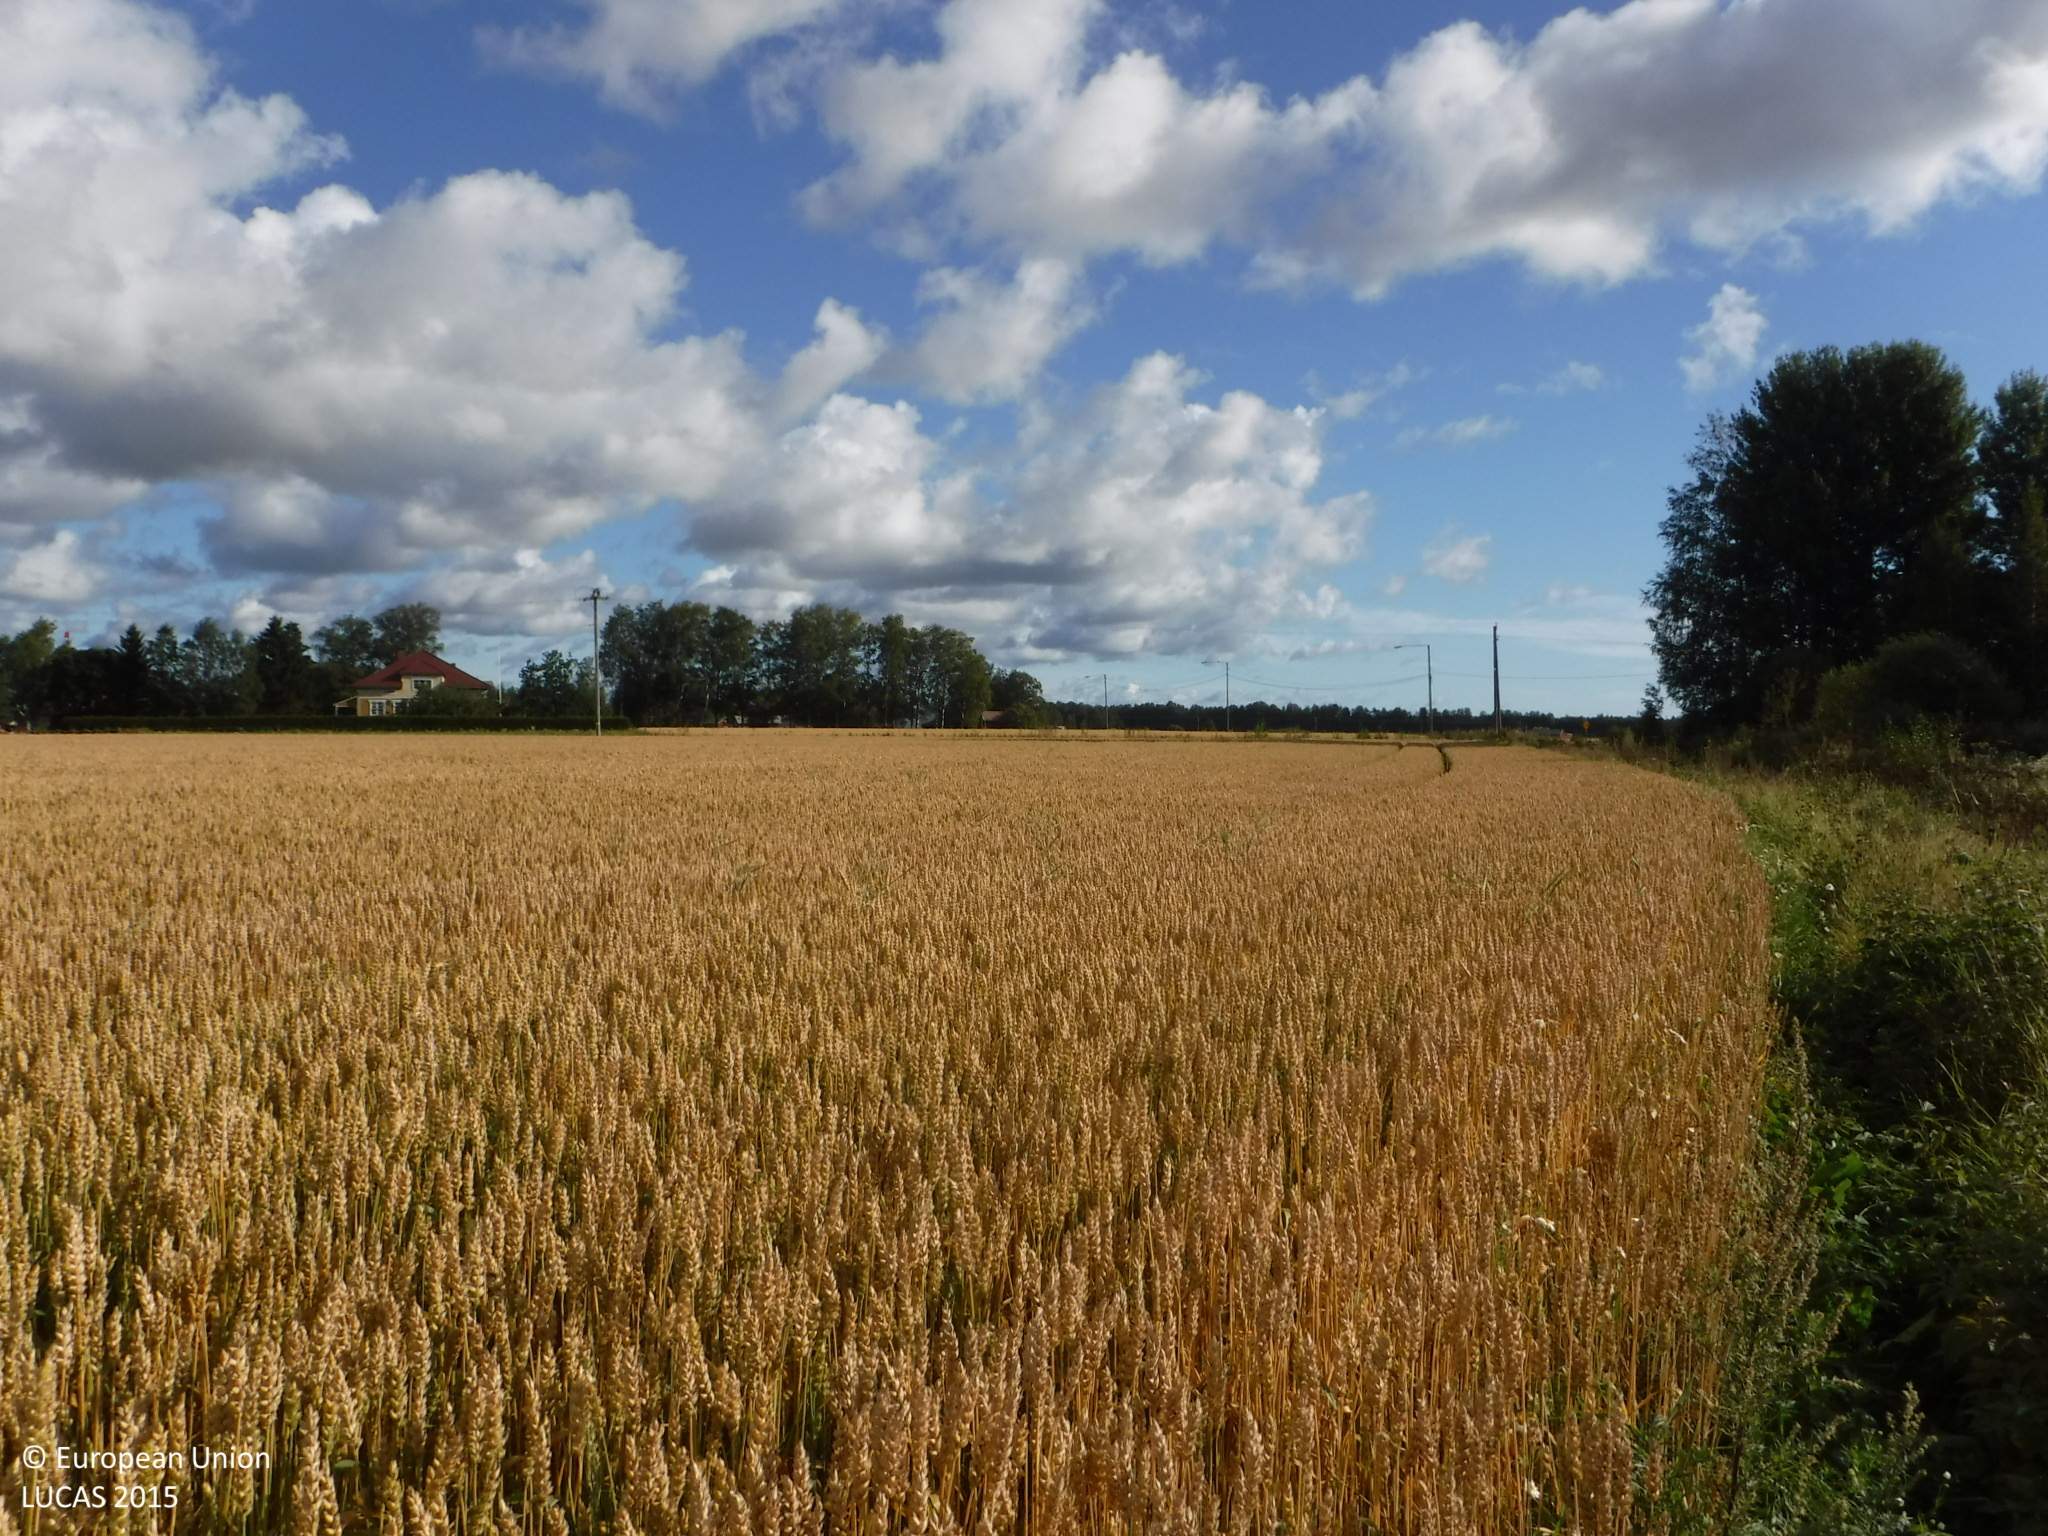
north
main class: Cropland
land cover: Common wheat
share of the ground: > 75 %
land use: Agriculture (excluding fallow land and kitchen gardens)
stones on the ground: < 10 %
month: August
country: FI
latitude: 61.3271
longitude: 21.9963
